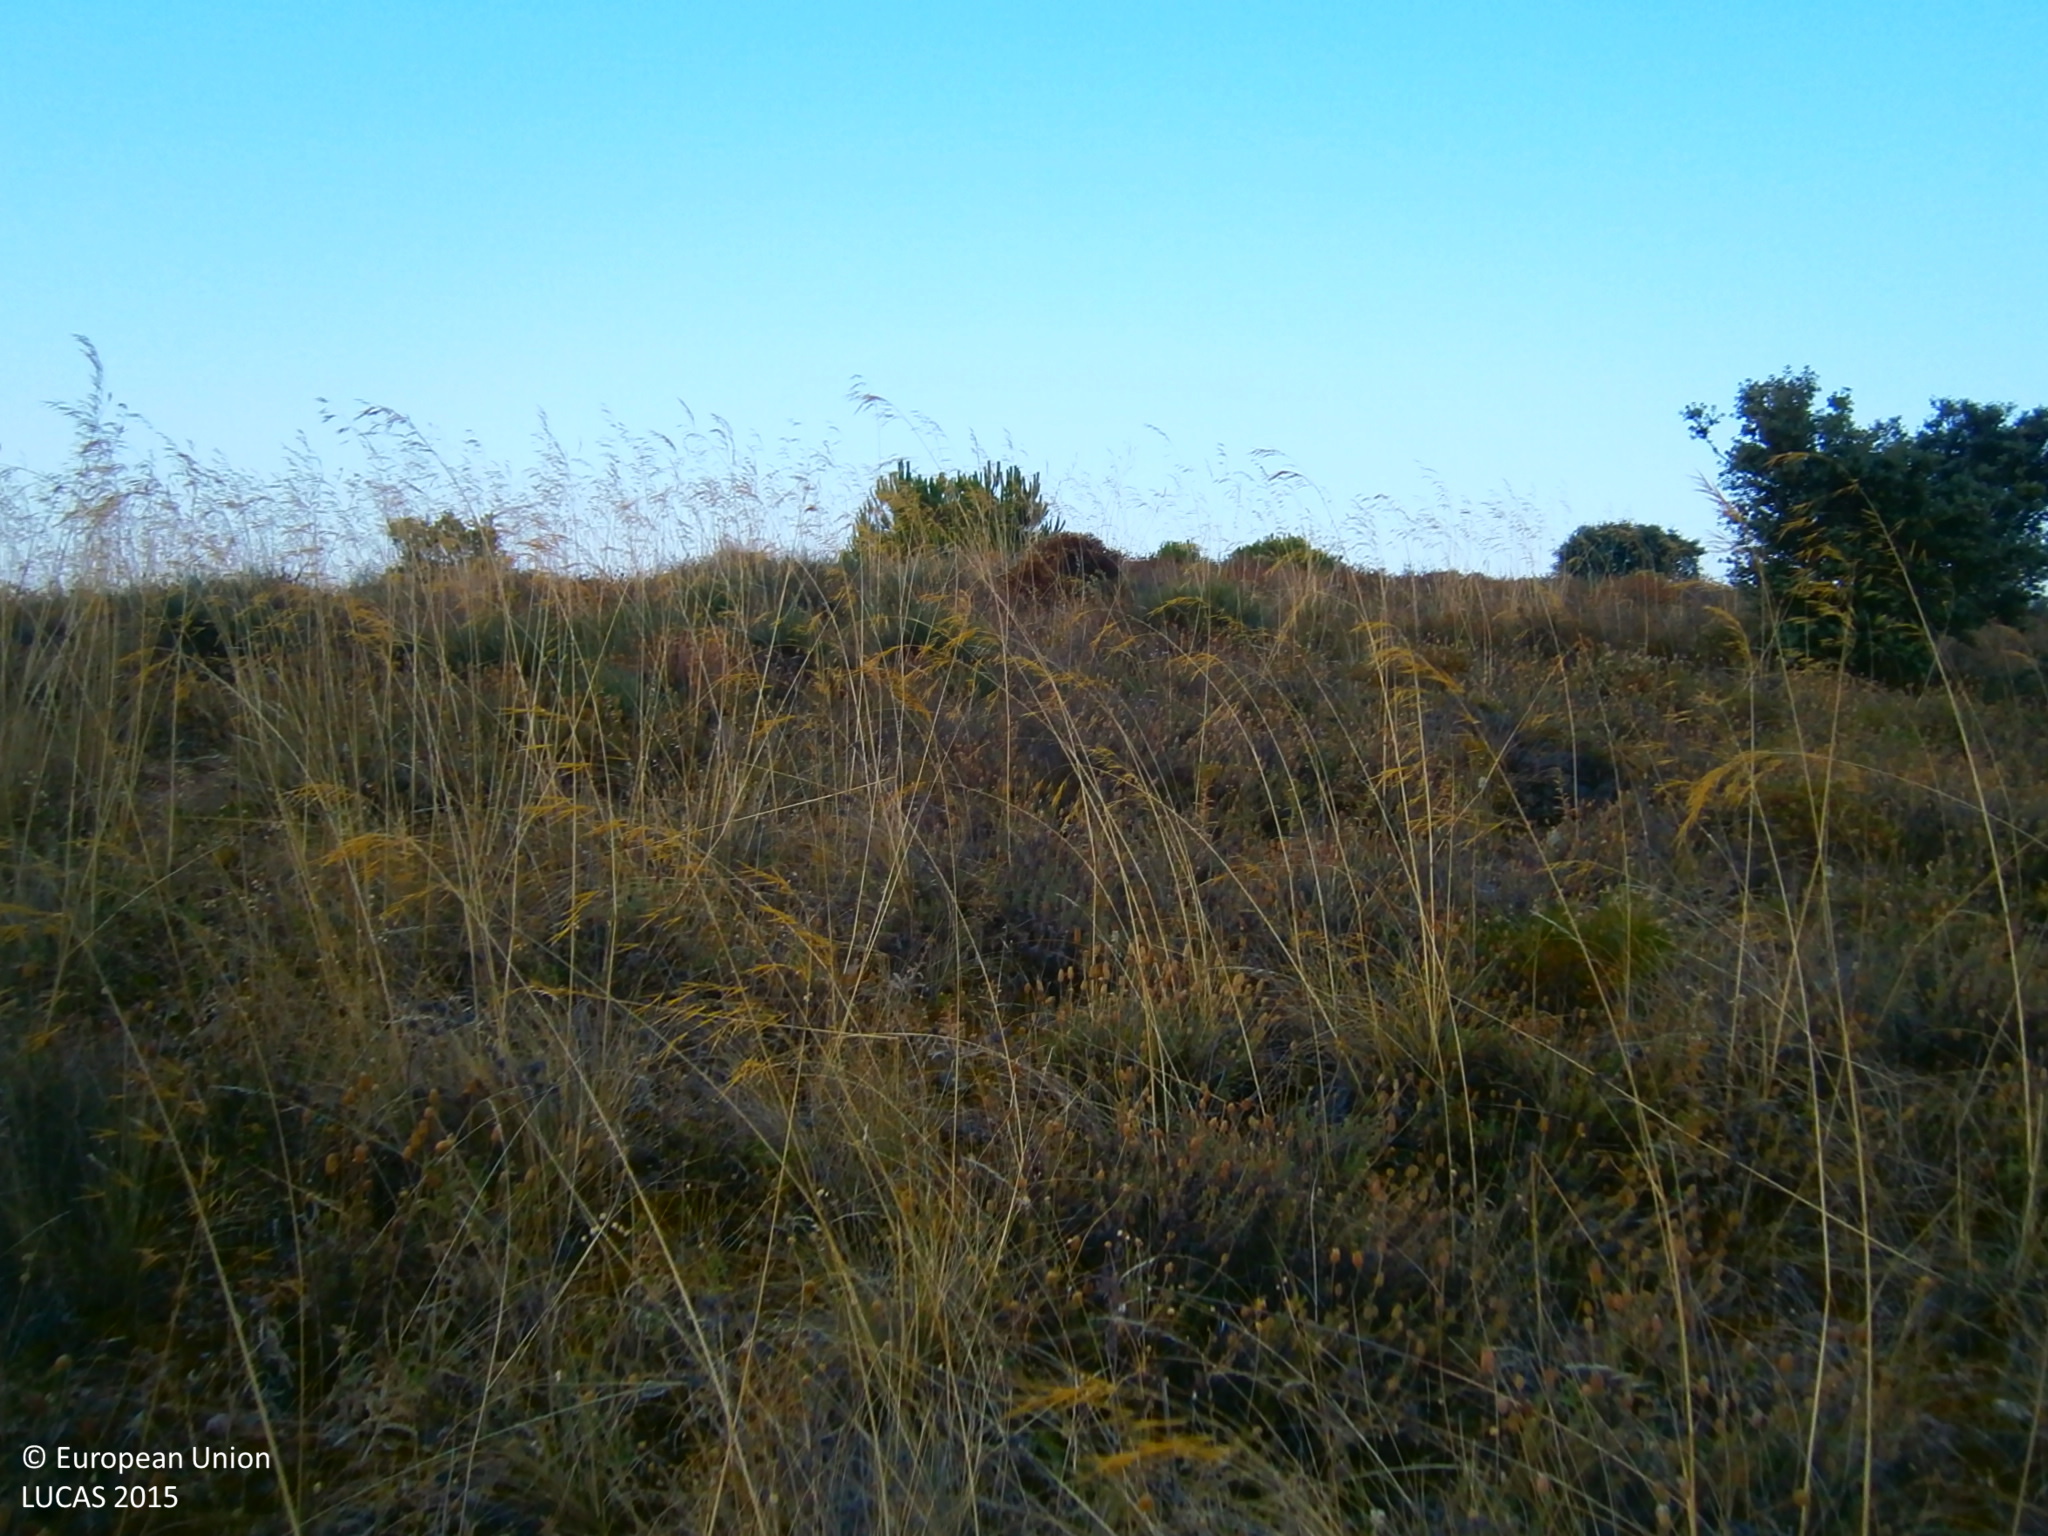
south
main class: Shrubland
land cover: Shrubland with sparse tree cover
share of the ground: > 75 %
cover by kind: shrubs 70 %, herbaceous plants 25 %, coniferous forest trees 5 %
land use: Abandoned areas
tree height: < 5 m
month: July
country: ES
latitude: 38.8460
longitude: -6.9952
